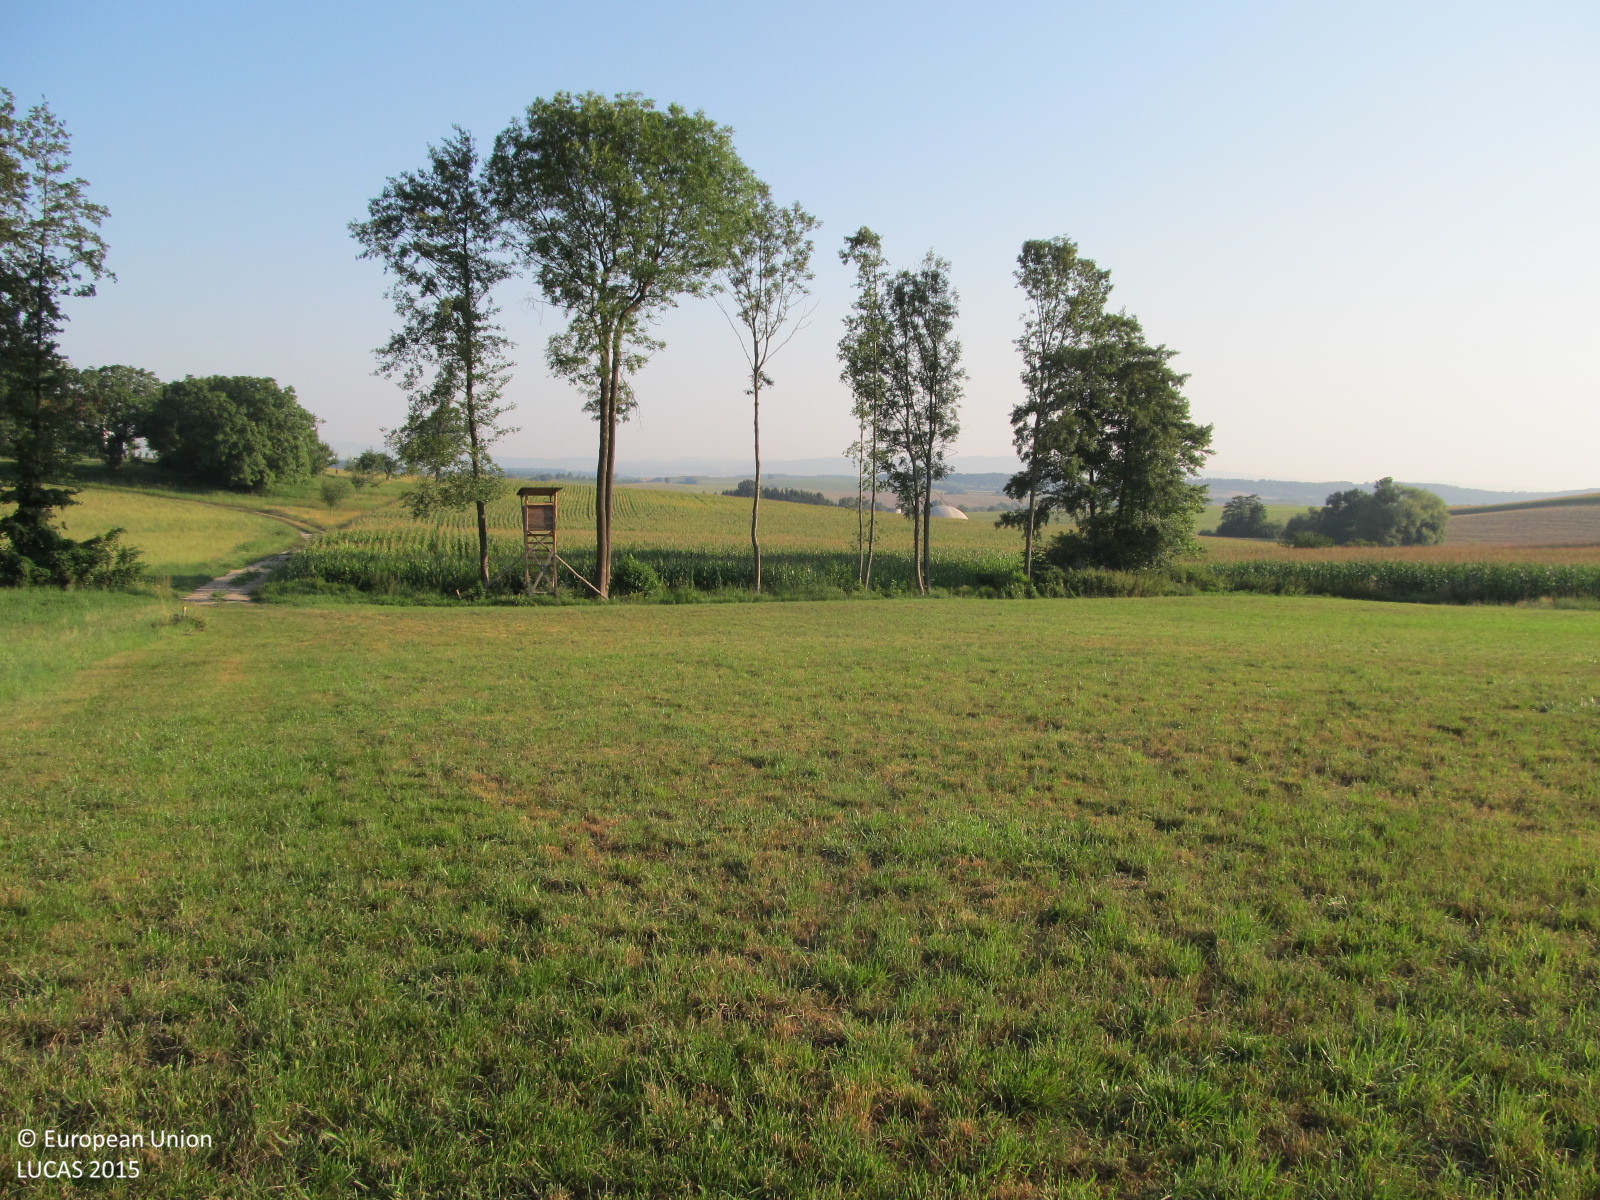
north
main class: Grassland
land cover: Grassland without tree/shrub cover
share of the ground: > 75 %
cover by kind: herbaceous plants 100 %
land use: Agriculture (excluding fallow land and kitchen gardens)
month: August
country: AT
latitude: 48.1072
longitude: 15.4413
